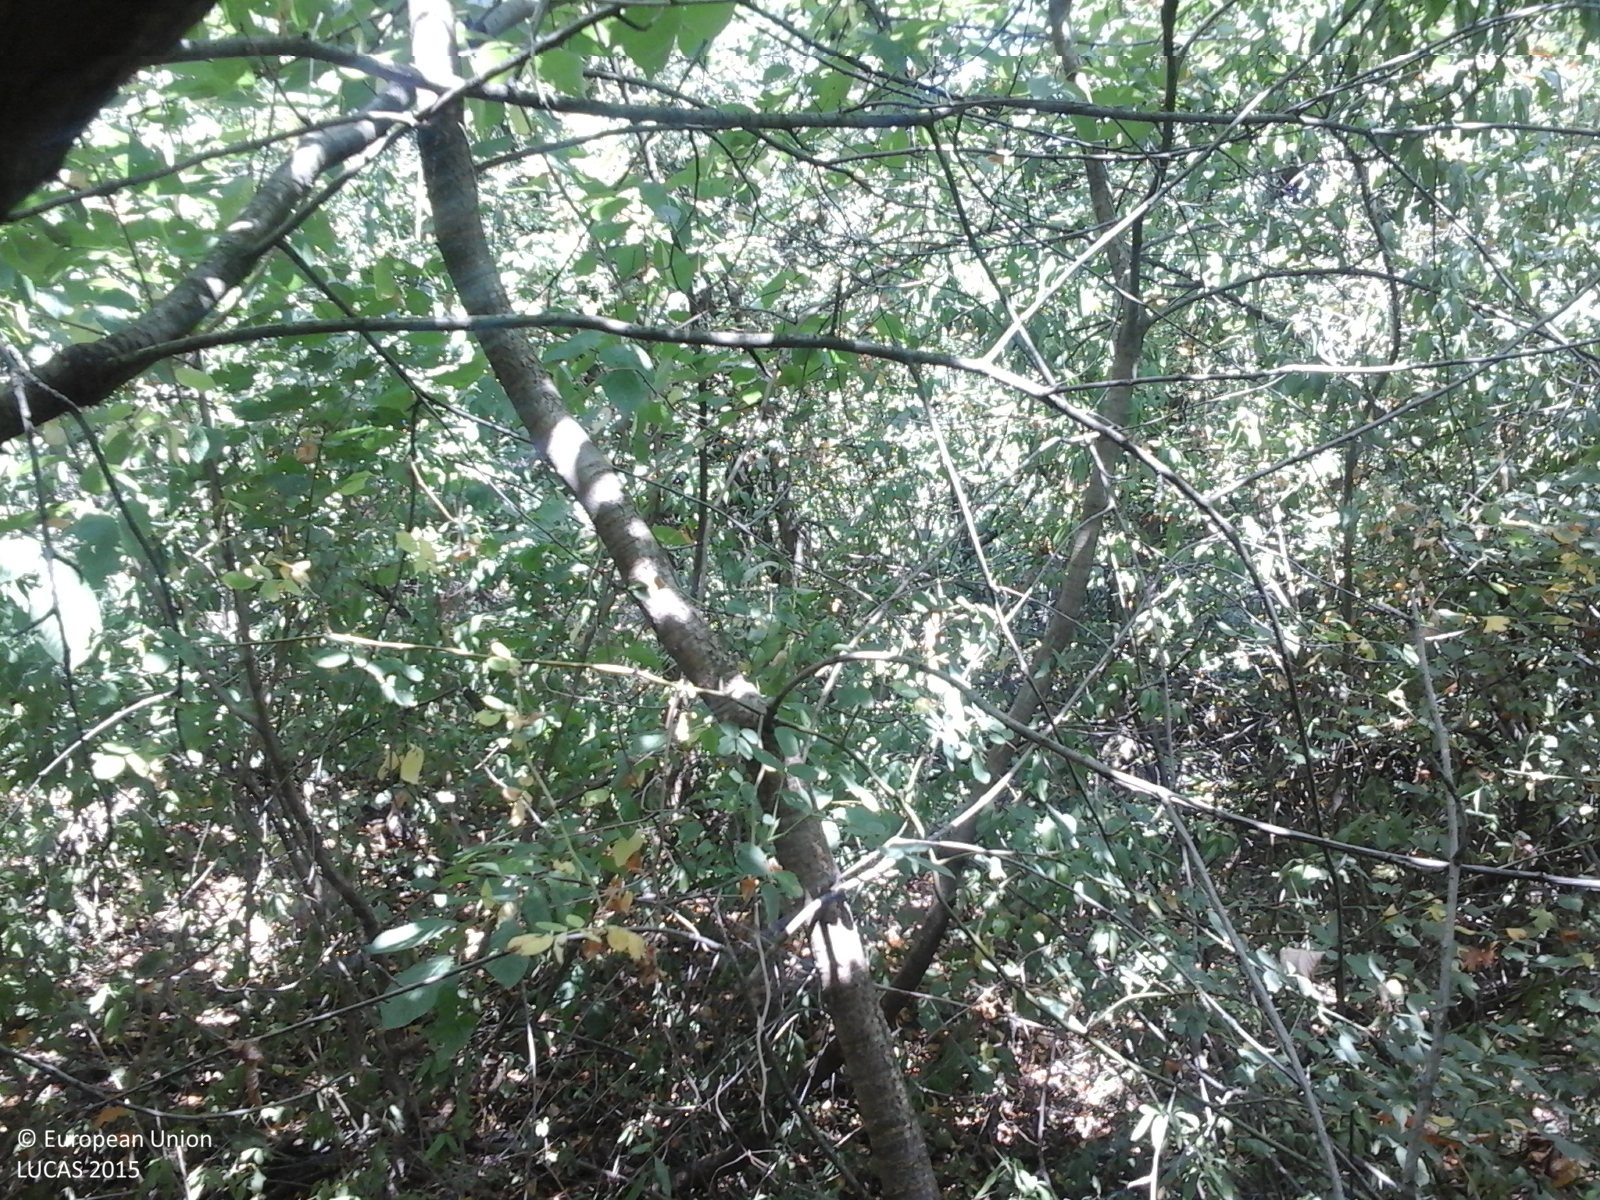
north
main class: Woodland
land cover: Broadleaved woodland
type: mesophytic deciduous forest
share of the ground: > 75 %
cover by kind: broadleaved forest trees 85 %, shrubs 10 %, herbaceous plants 5 %
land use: Forestry
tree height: > 5 m
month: July
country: RO
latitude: 46.2737
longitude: 27.6179
